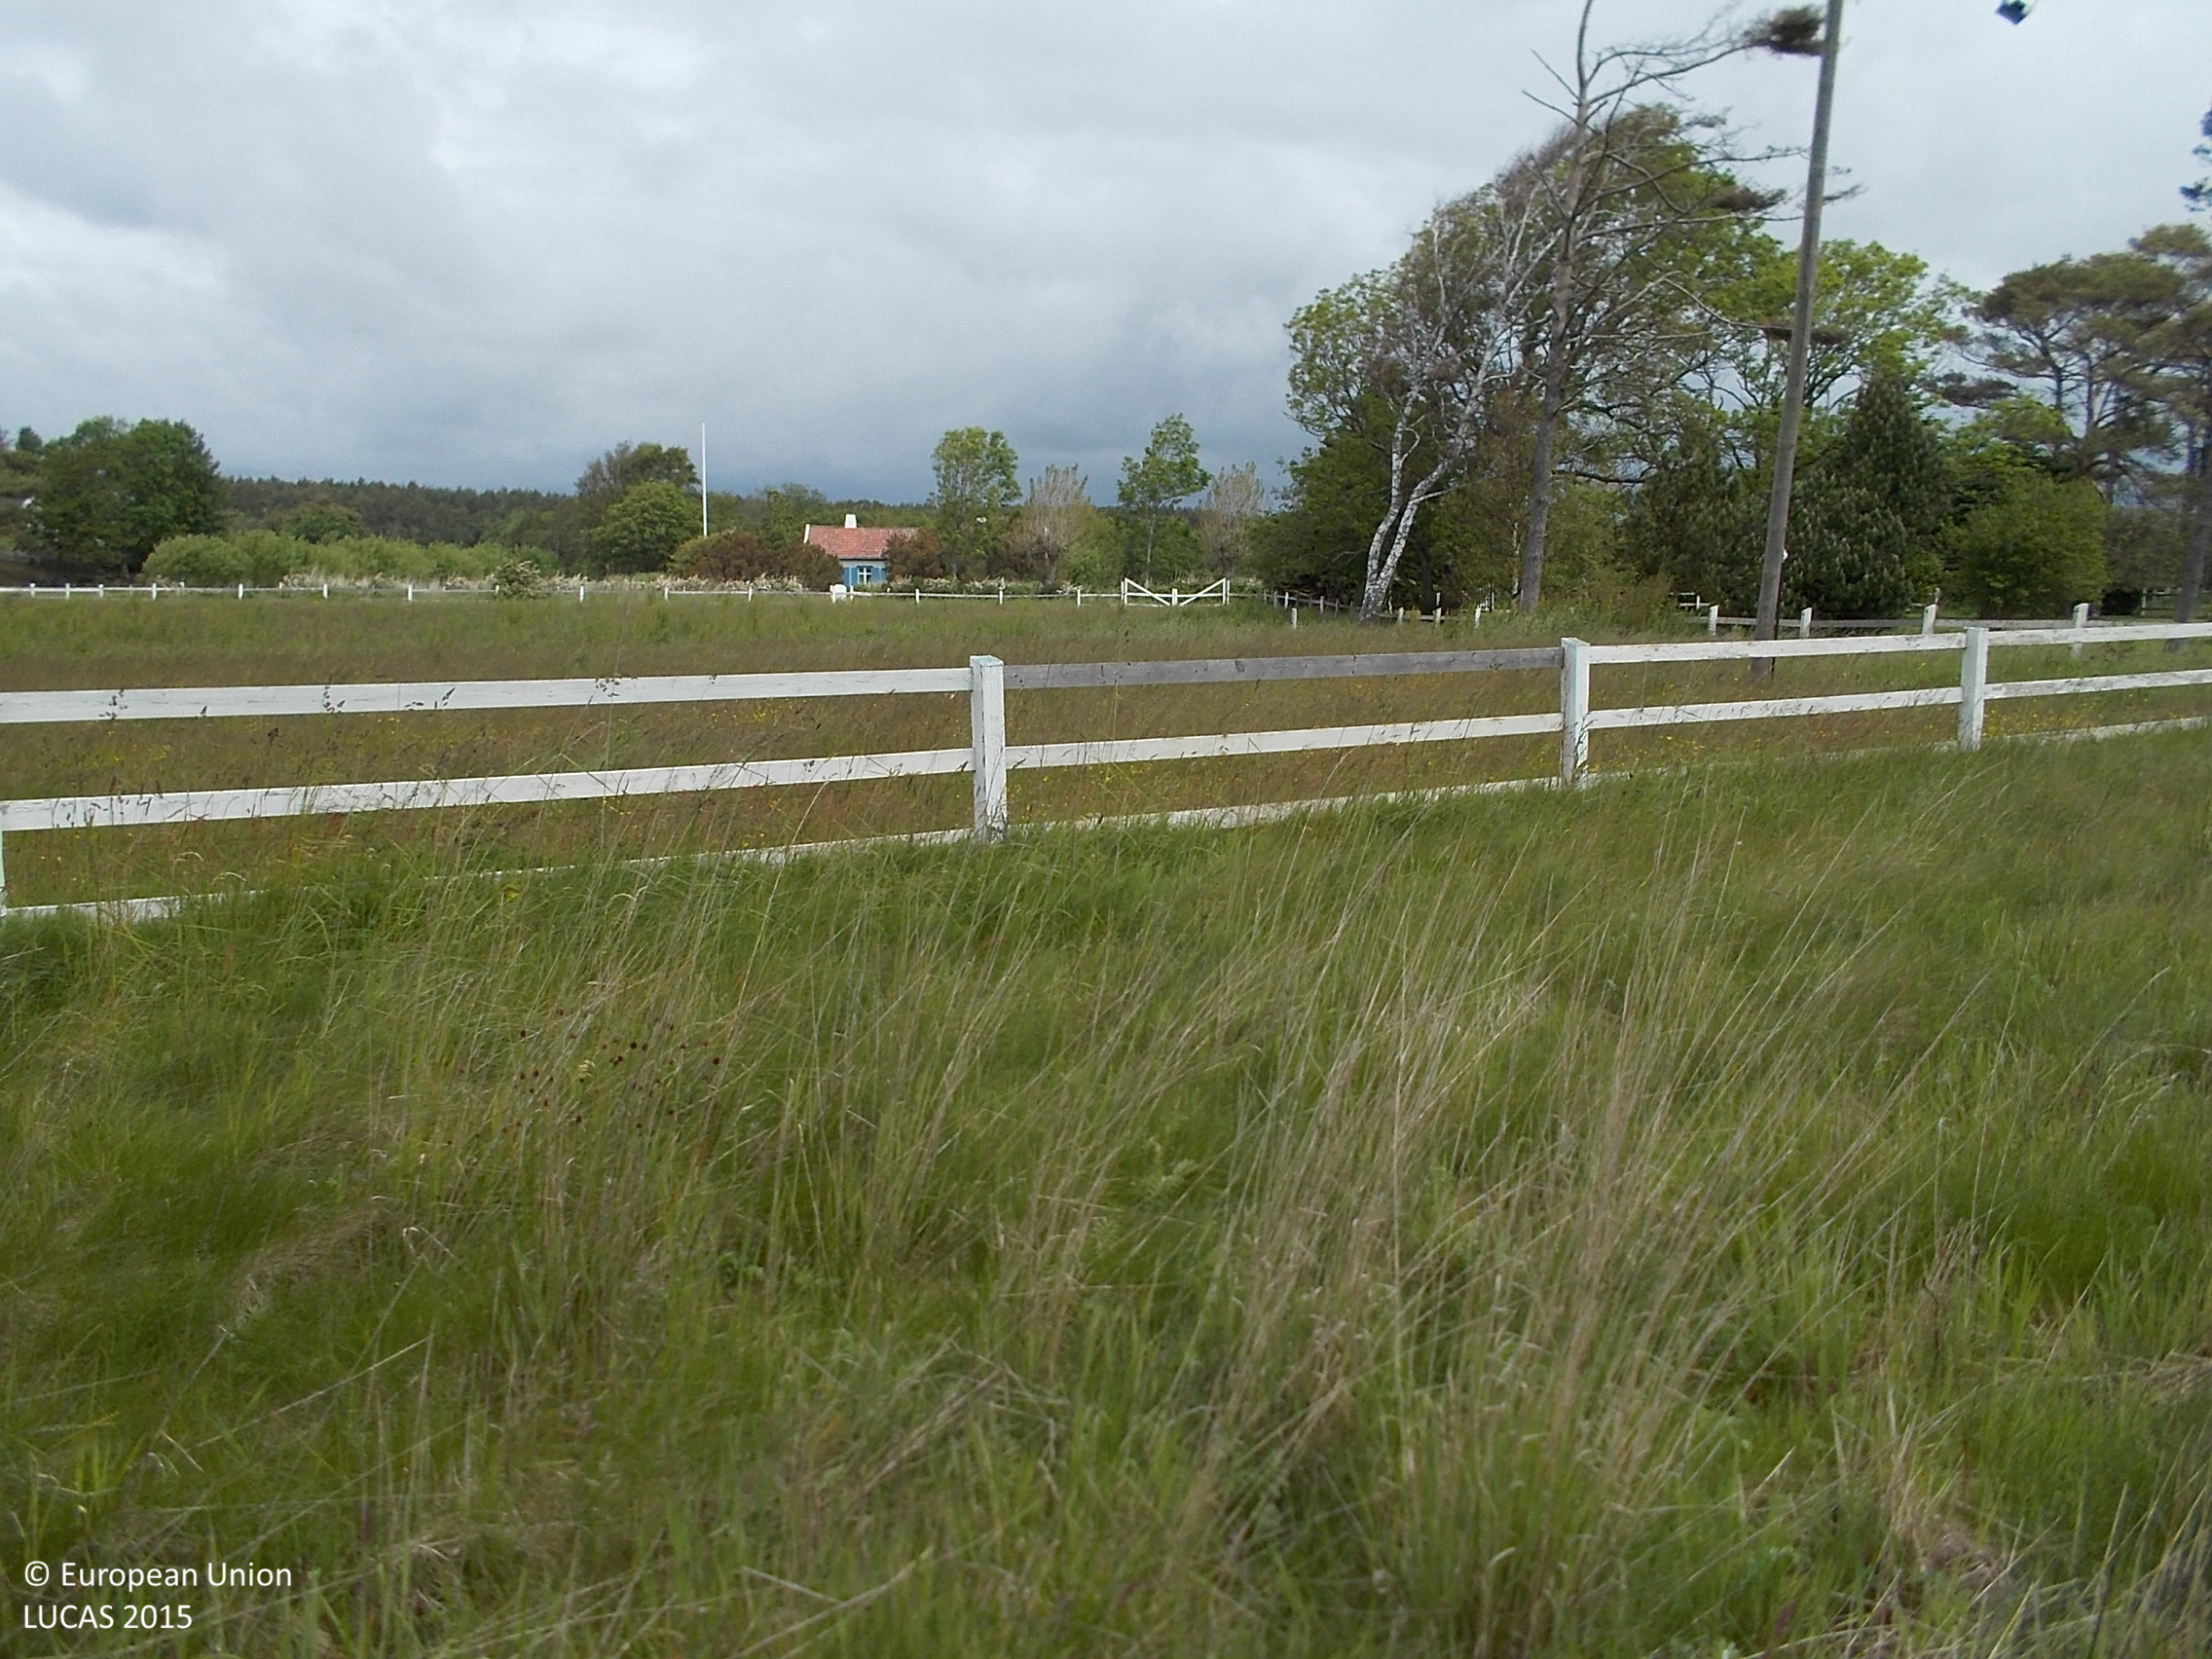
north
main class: Grassland
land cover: Grassland with sparse tree/shrub cover
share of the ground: > 75 %
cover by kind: herbaceous plants 90 %, broadleaved forest trees 5 %, shrubs 5 %
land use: Abandoned areas
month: June
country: SE
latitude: 57.3959
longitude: 11.9439
